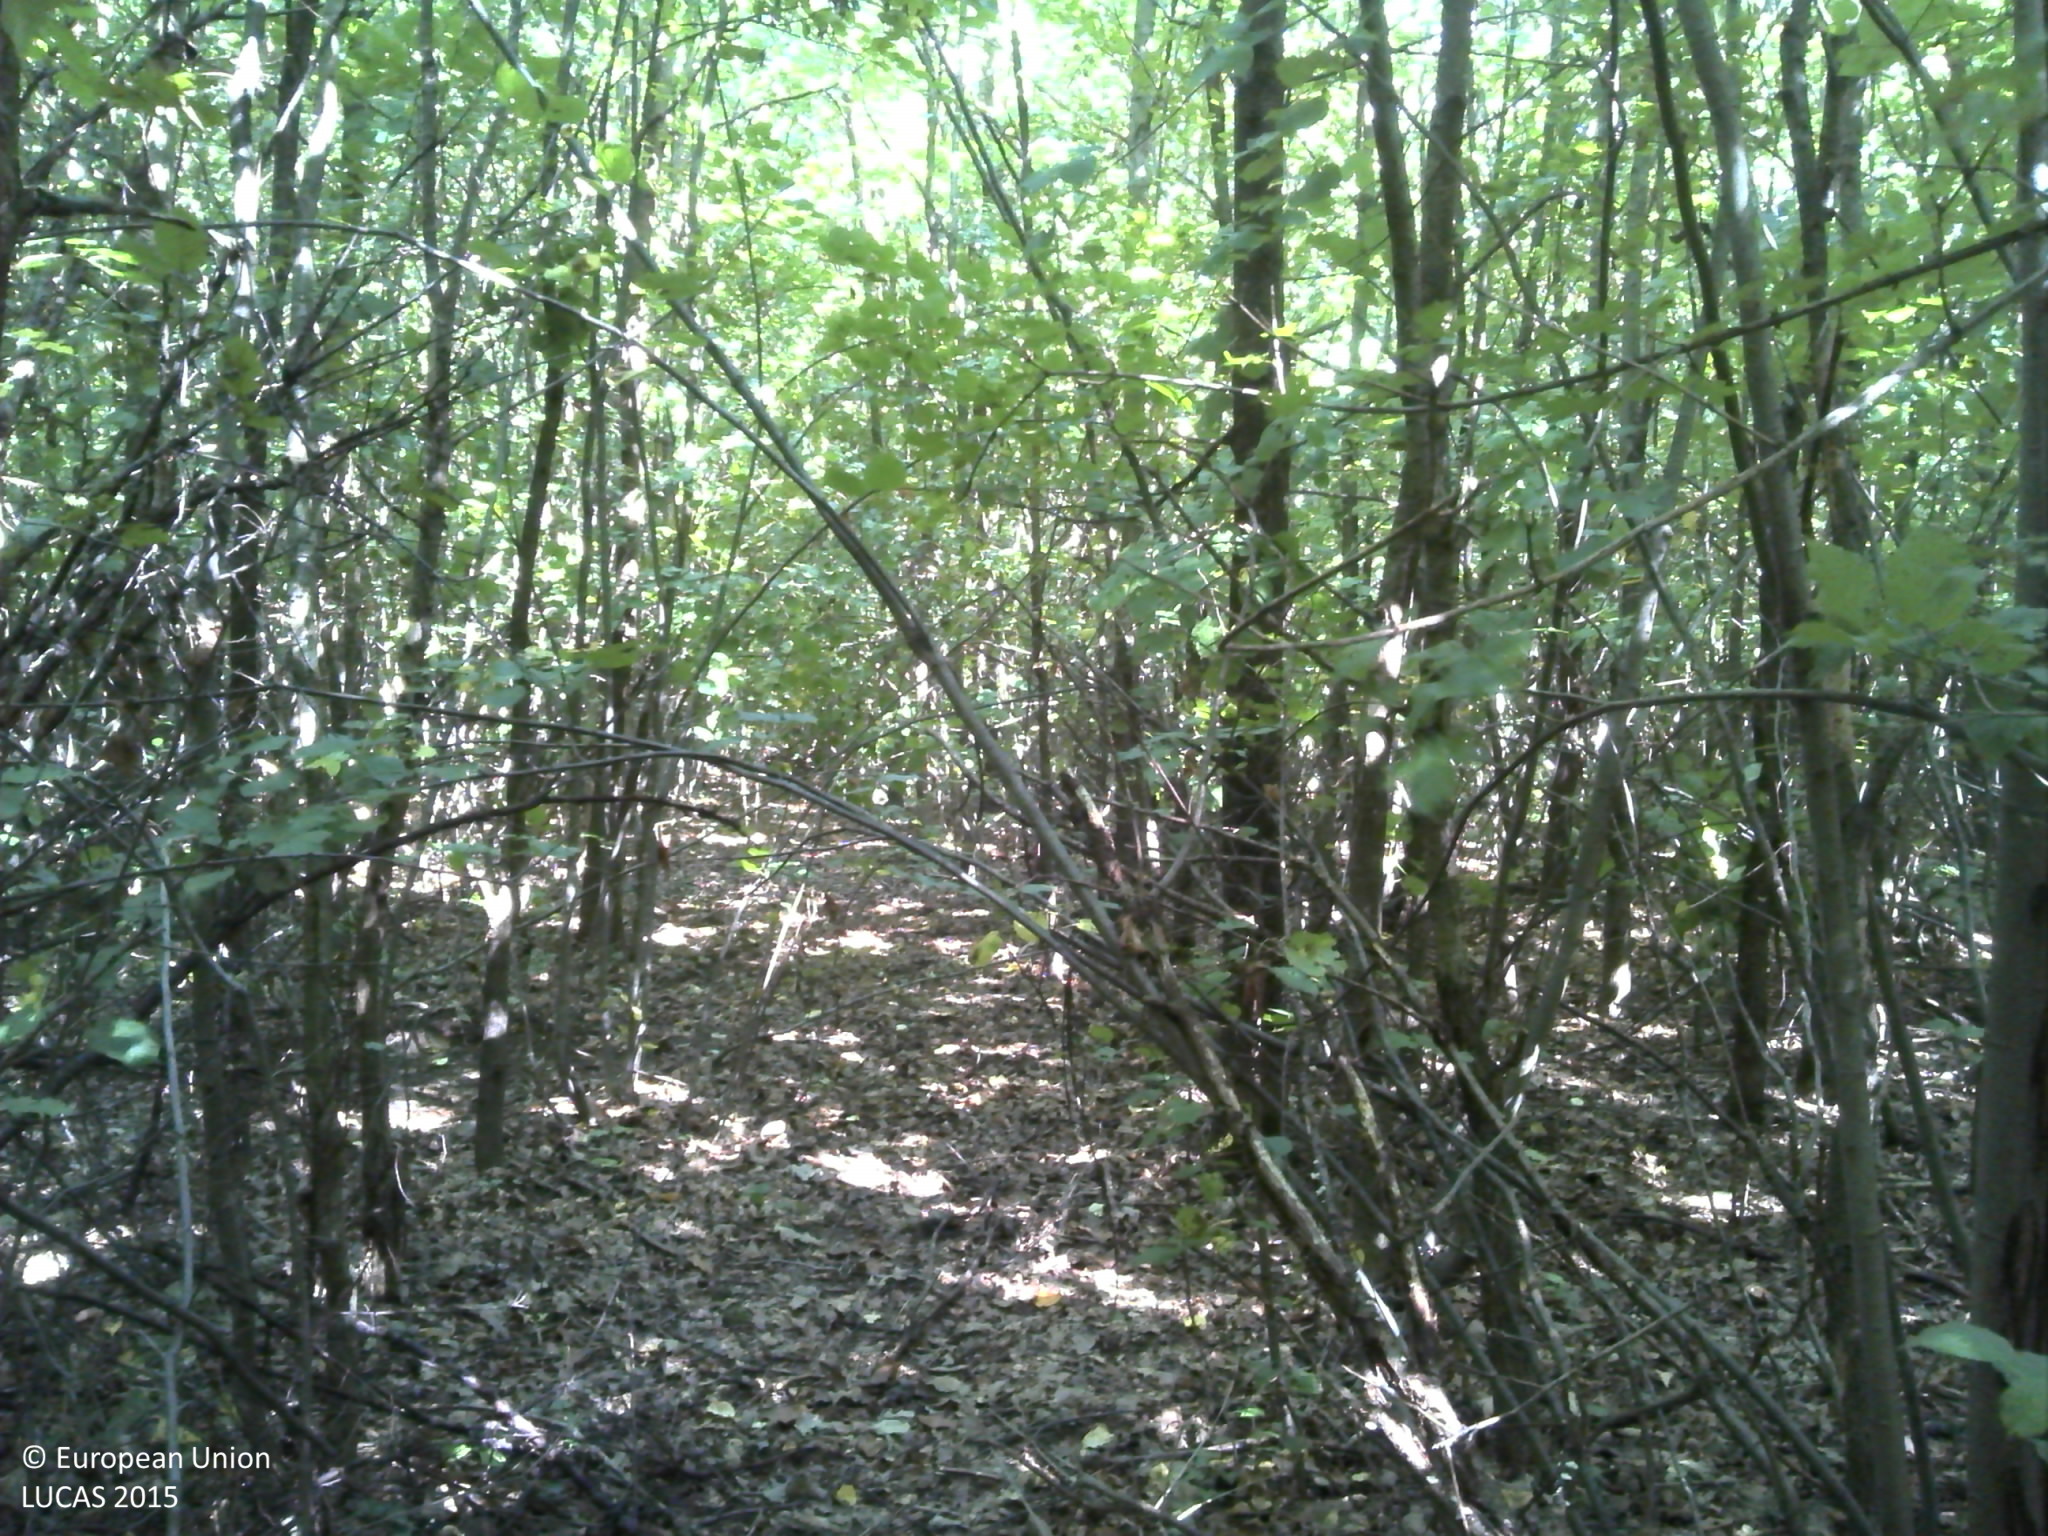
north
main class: Woodland
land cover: Broadleaved woodland
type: acidophilous oak and oak-birch forest
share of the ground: > 75 %
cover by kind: broadleaved forest trees 100 %
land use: Forestry
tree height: > 5 m
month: September
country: HR
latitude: 45.7123
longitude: 18.6277
